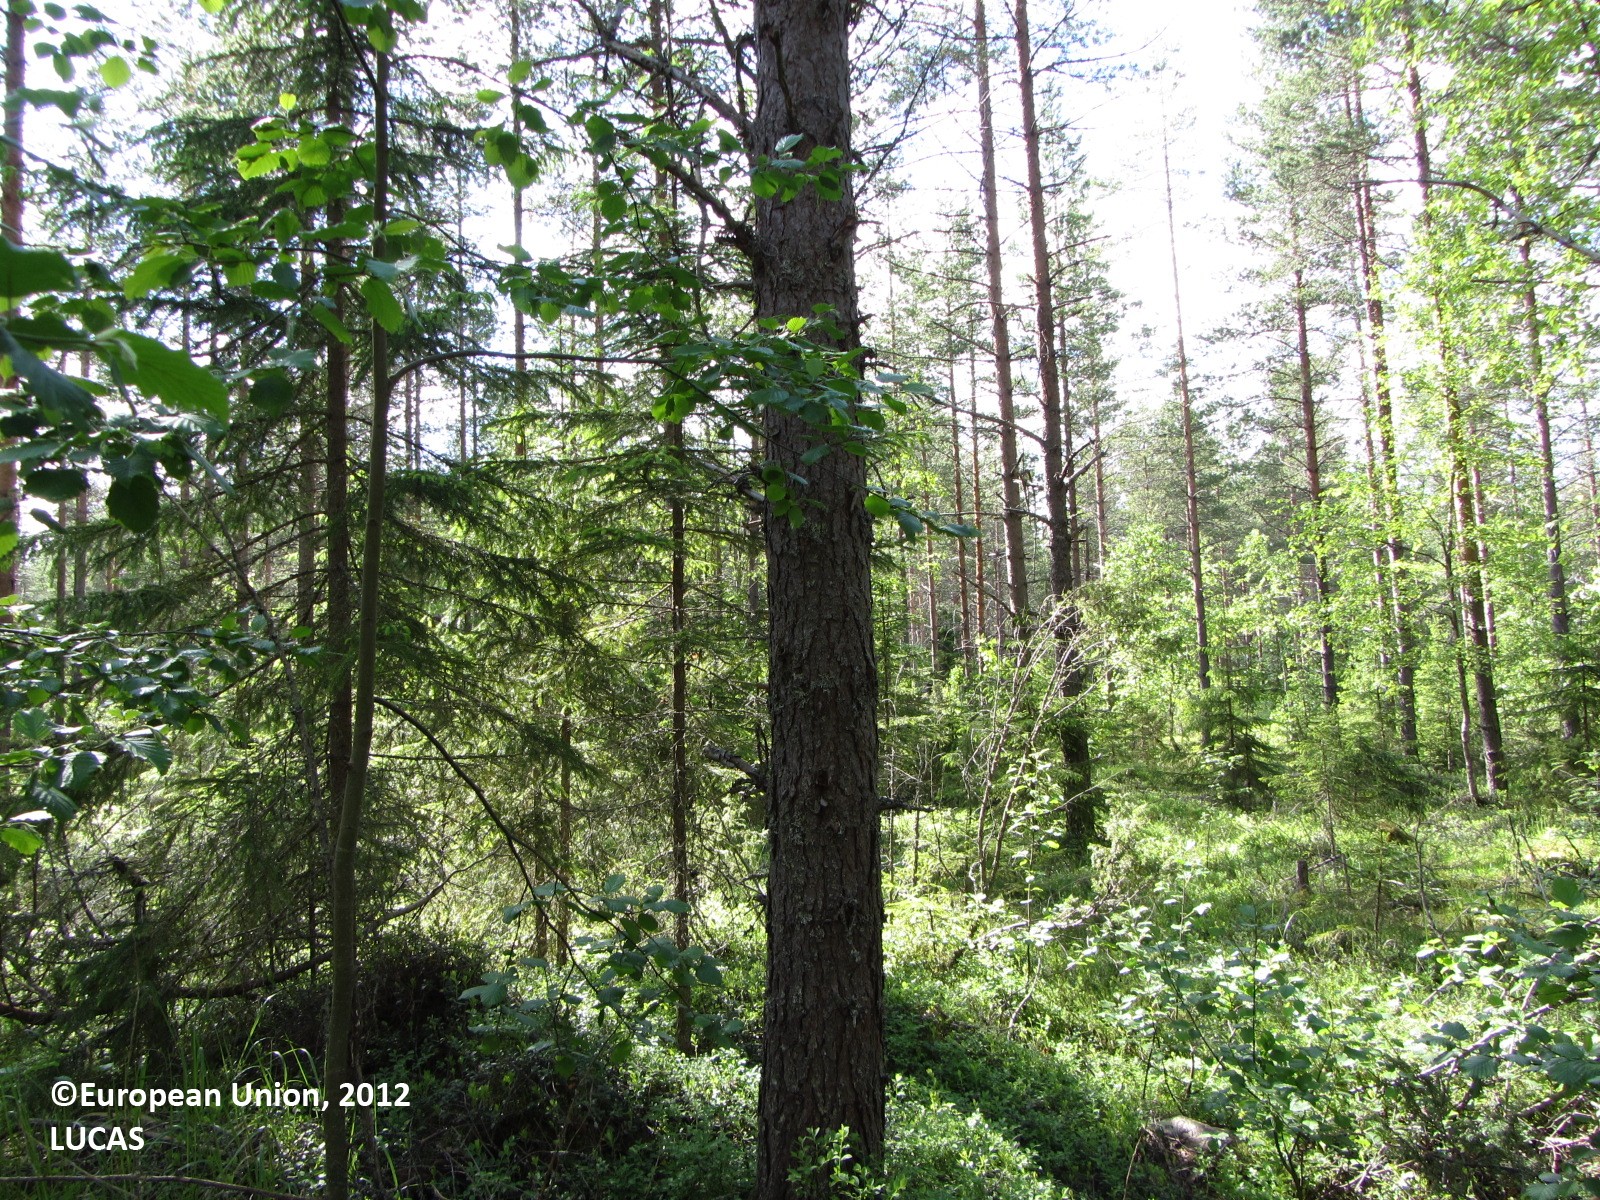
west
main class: Woodland
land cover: Pine dominated coniferous woodland
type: boreal forest
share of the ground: > 75 %
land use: Forestry
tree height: > 5 m
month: June
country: FI
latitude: 62.2708
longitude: 25.0730
